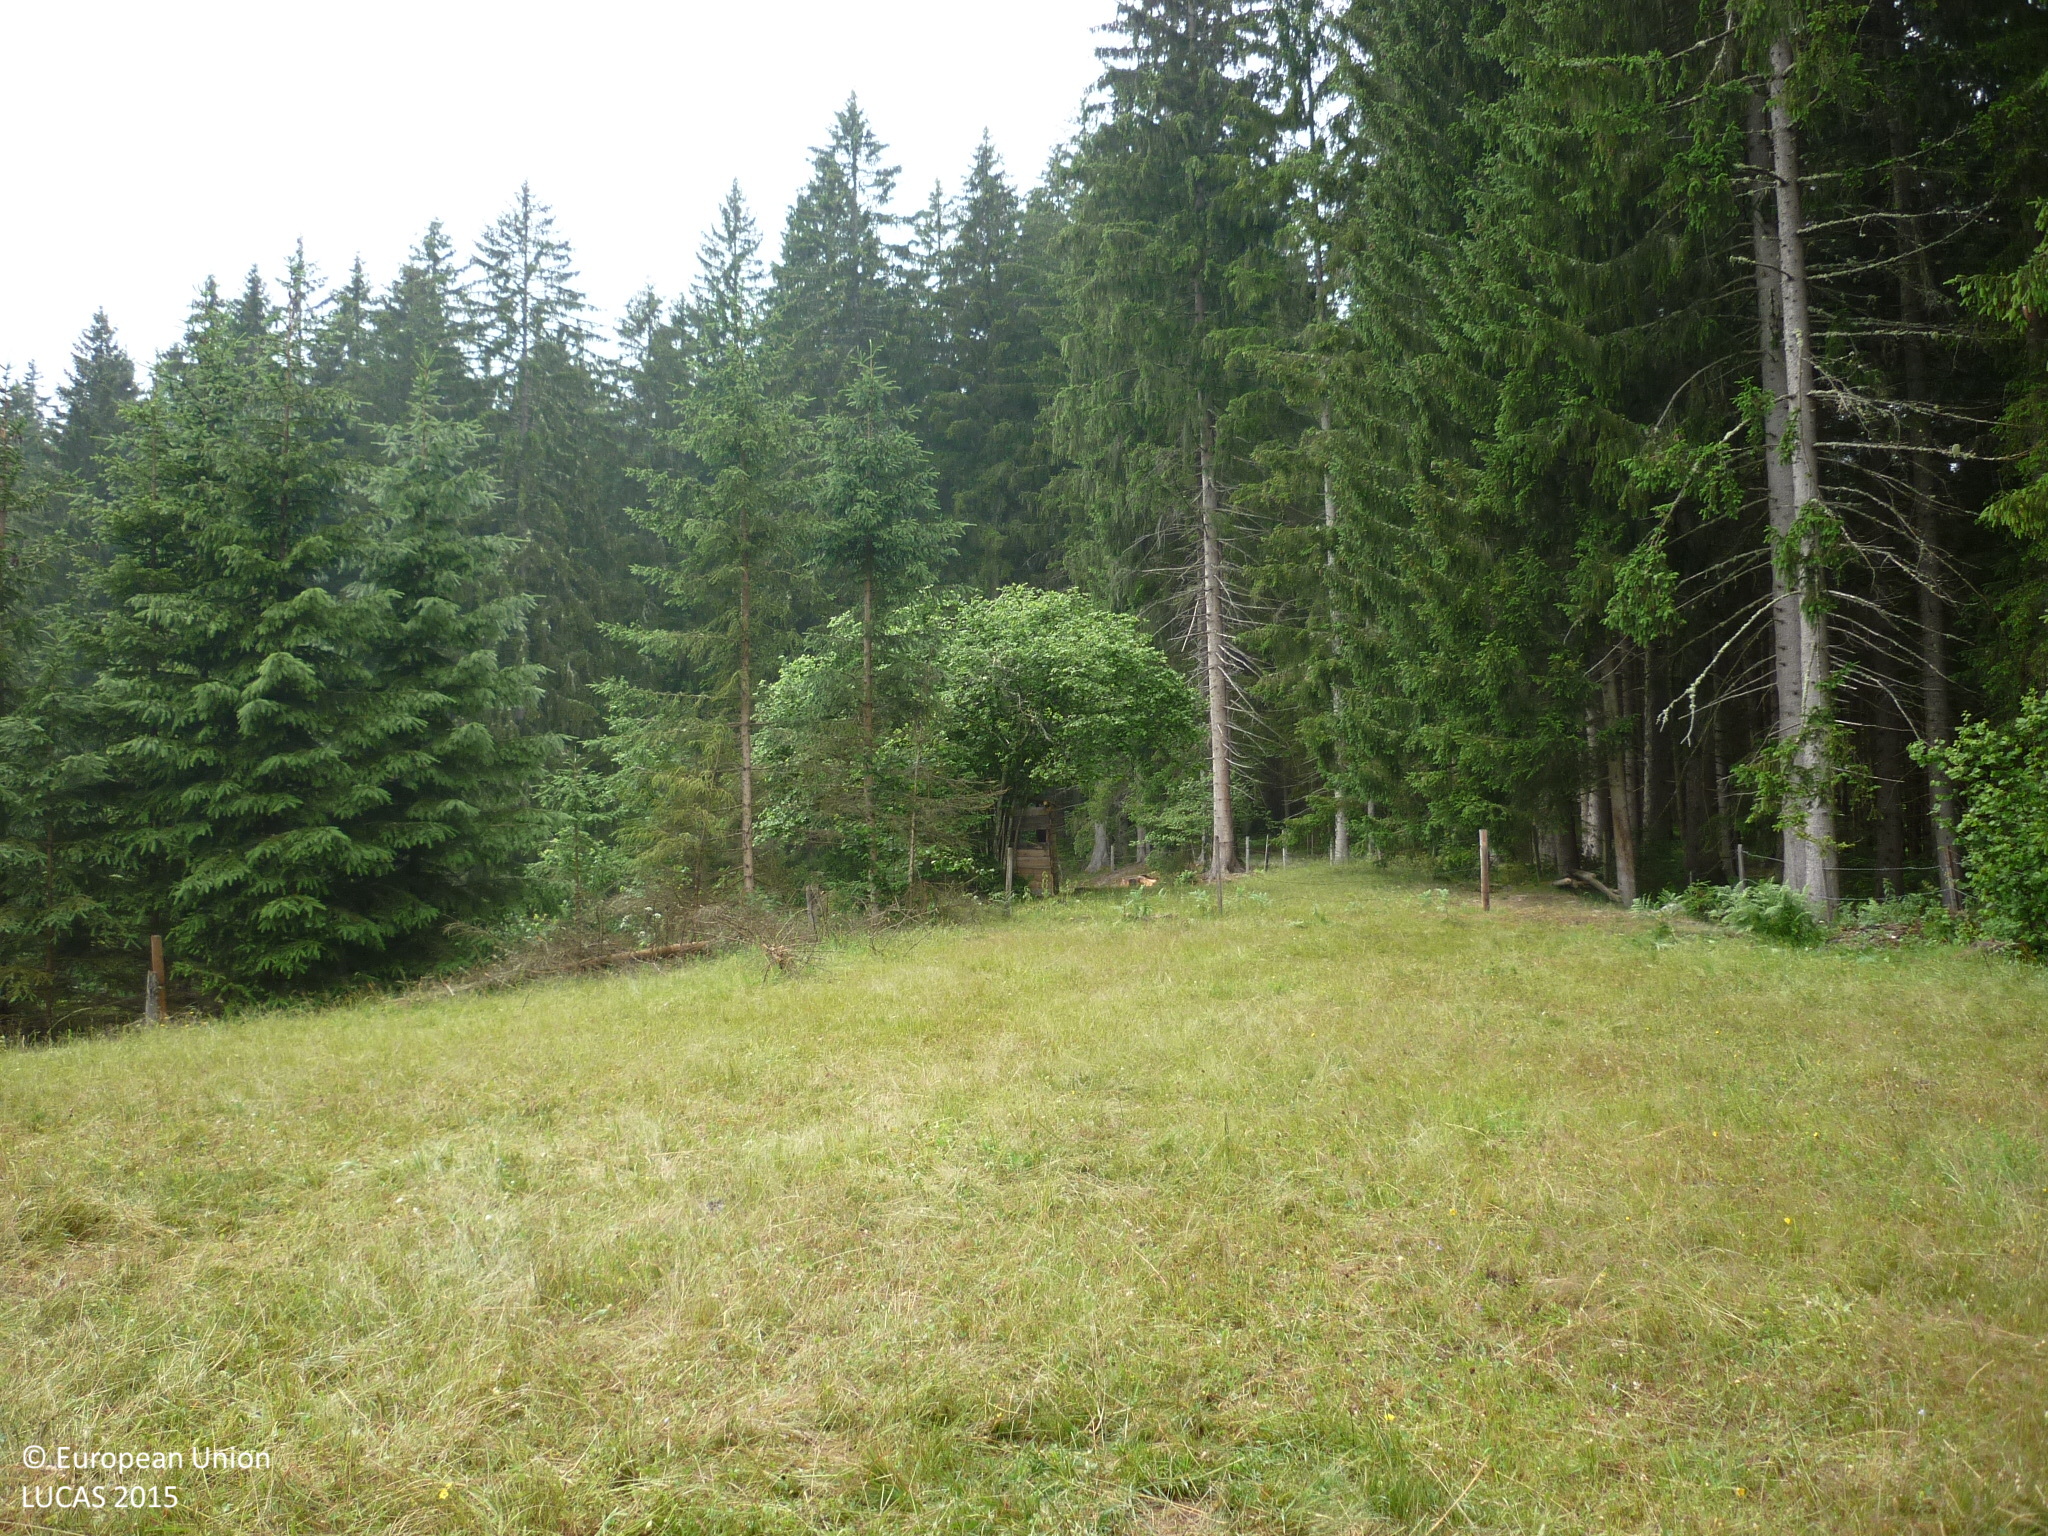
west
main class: Grassland
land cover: Grassland without tree/shrub cover
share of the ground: > 75 %
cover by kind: herbaceous plants 100 %
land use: Agriculture (excluding fallow land and kitchen gardens)
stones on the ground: < 10 %
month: June
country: AT
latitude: 47.0919
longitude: 14.3588
